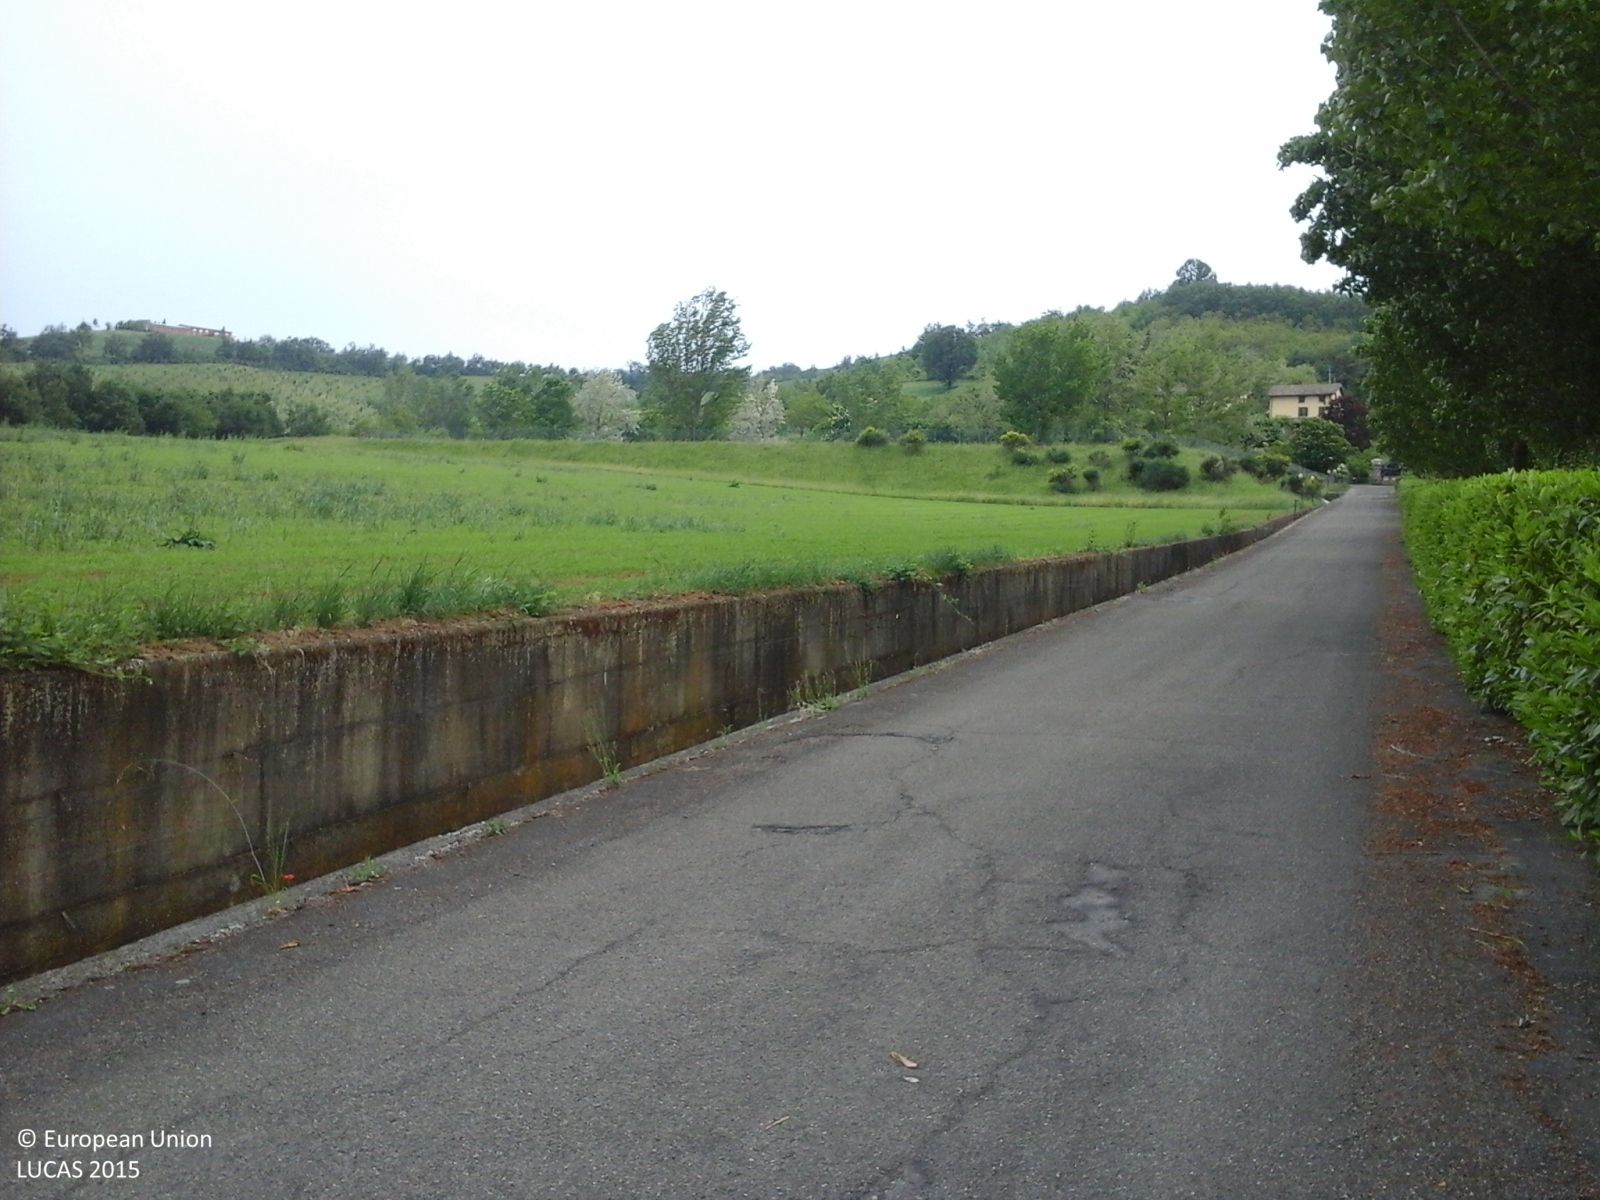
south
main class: Woodland
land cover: Broadleaved woodland
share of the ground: > 75 %
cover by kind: broadleaved forest trees 80 %, herbaceous plants 20 %
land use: Residential
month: May
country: IT
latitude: 44.5825
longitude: 10.7163
